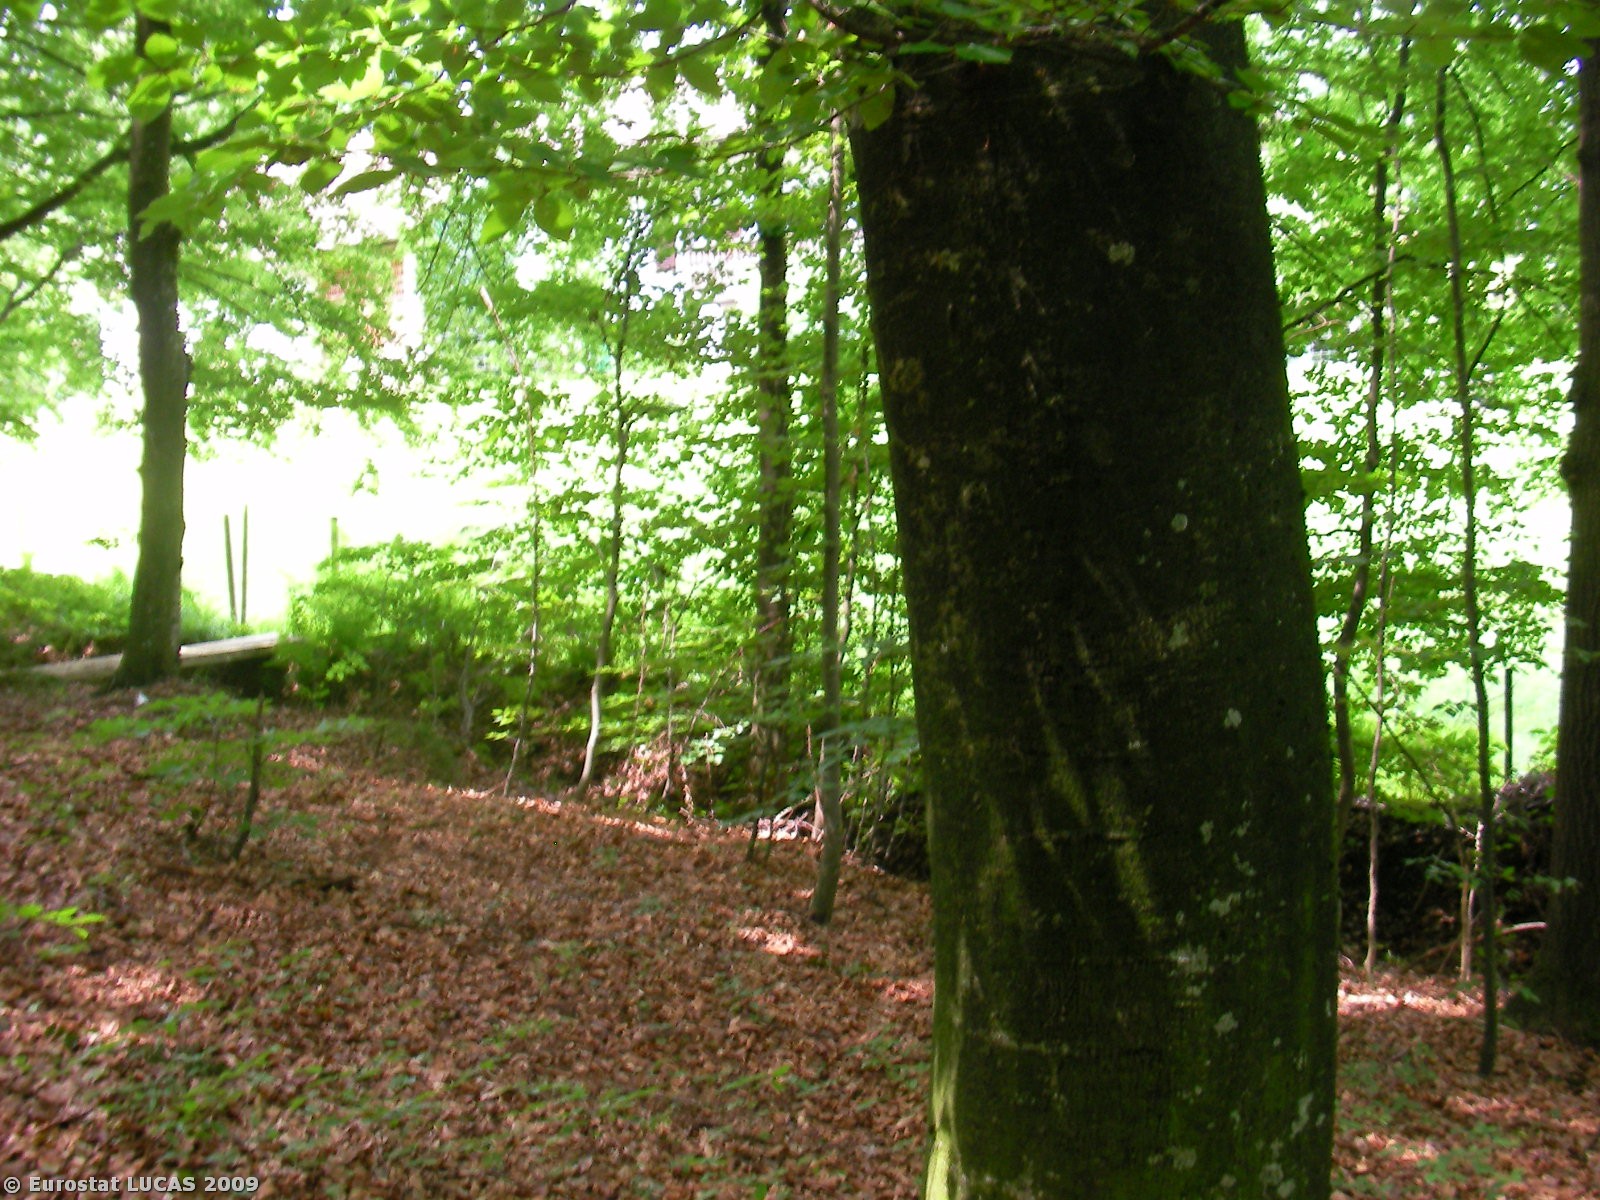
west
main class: Woodland
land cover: Mixed woodland
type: hemiboreal forest and nemoral coniferous forest and mixed broadleaved-coniferous forest
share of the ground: > 75 %
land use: Forestry
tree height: > 5 m
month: June
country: AT
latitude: 47.0283
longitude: 15.7241
